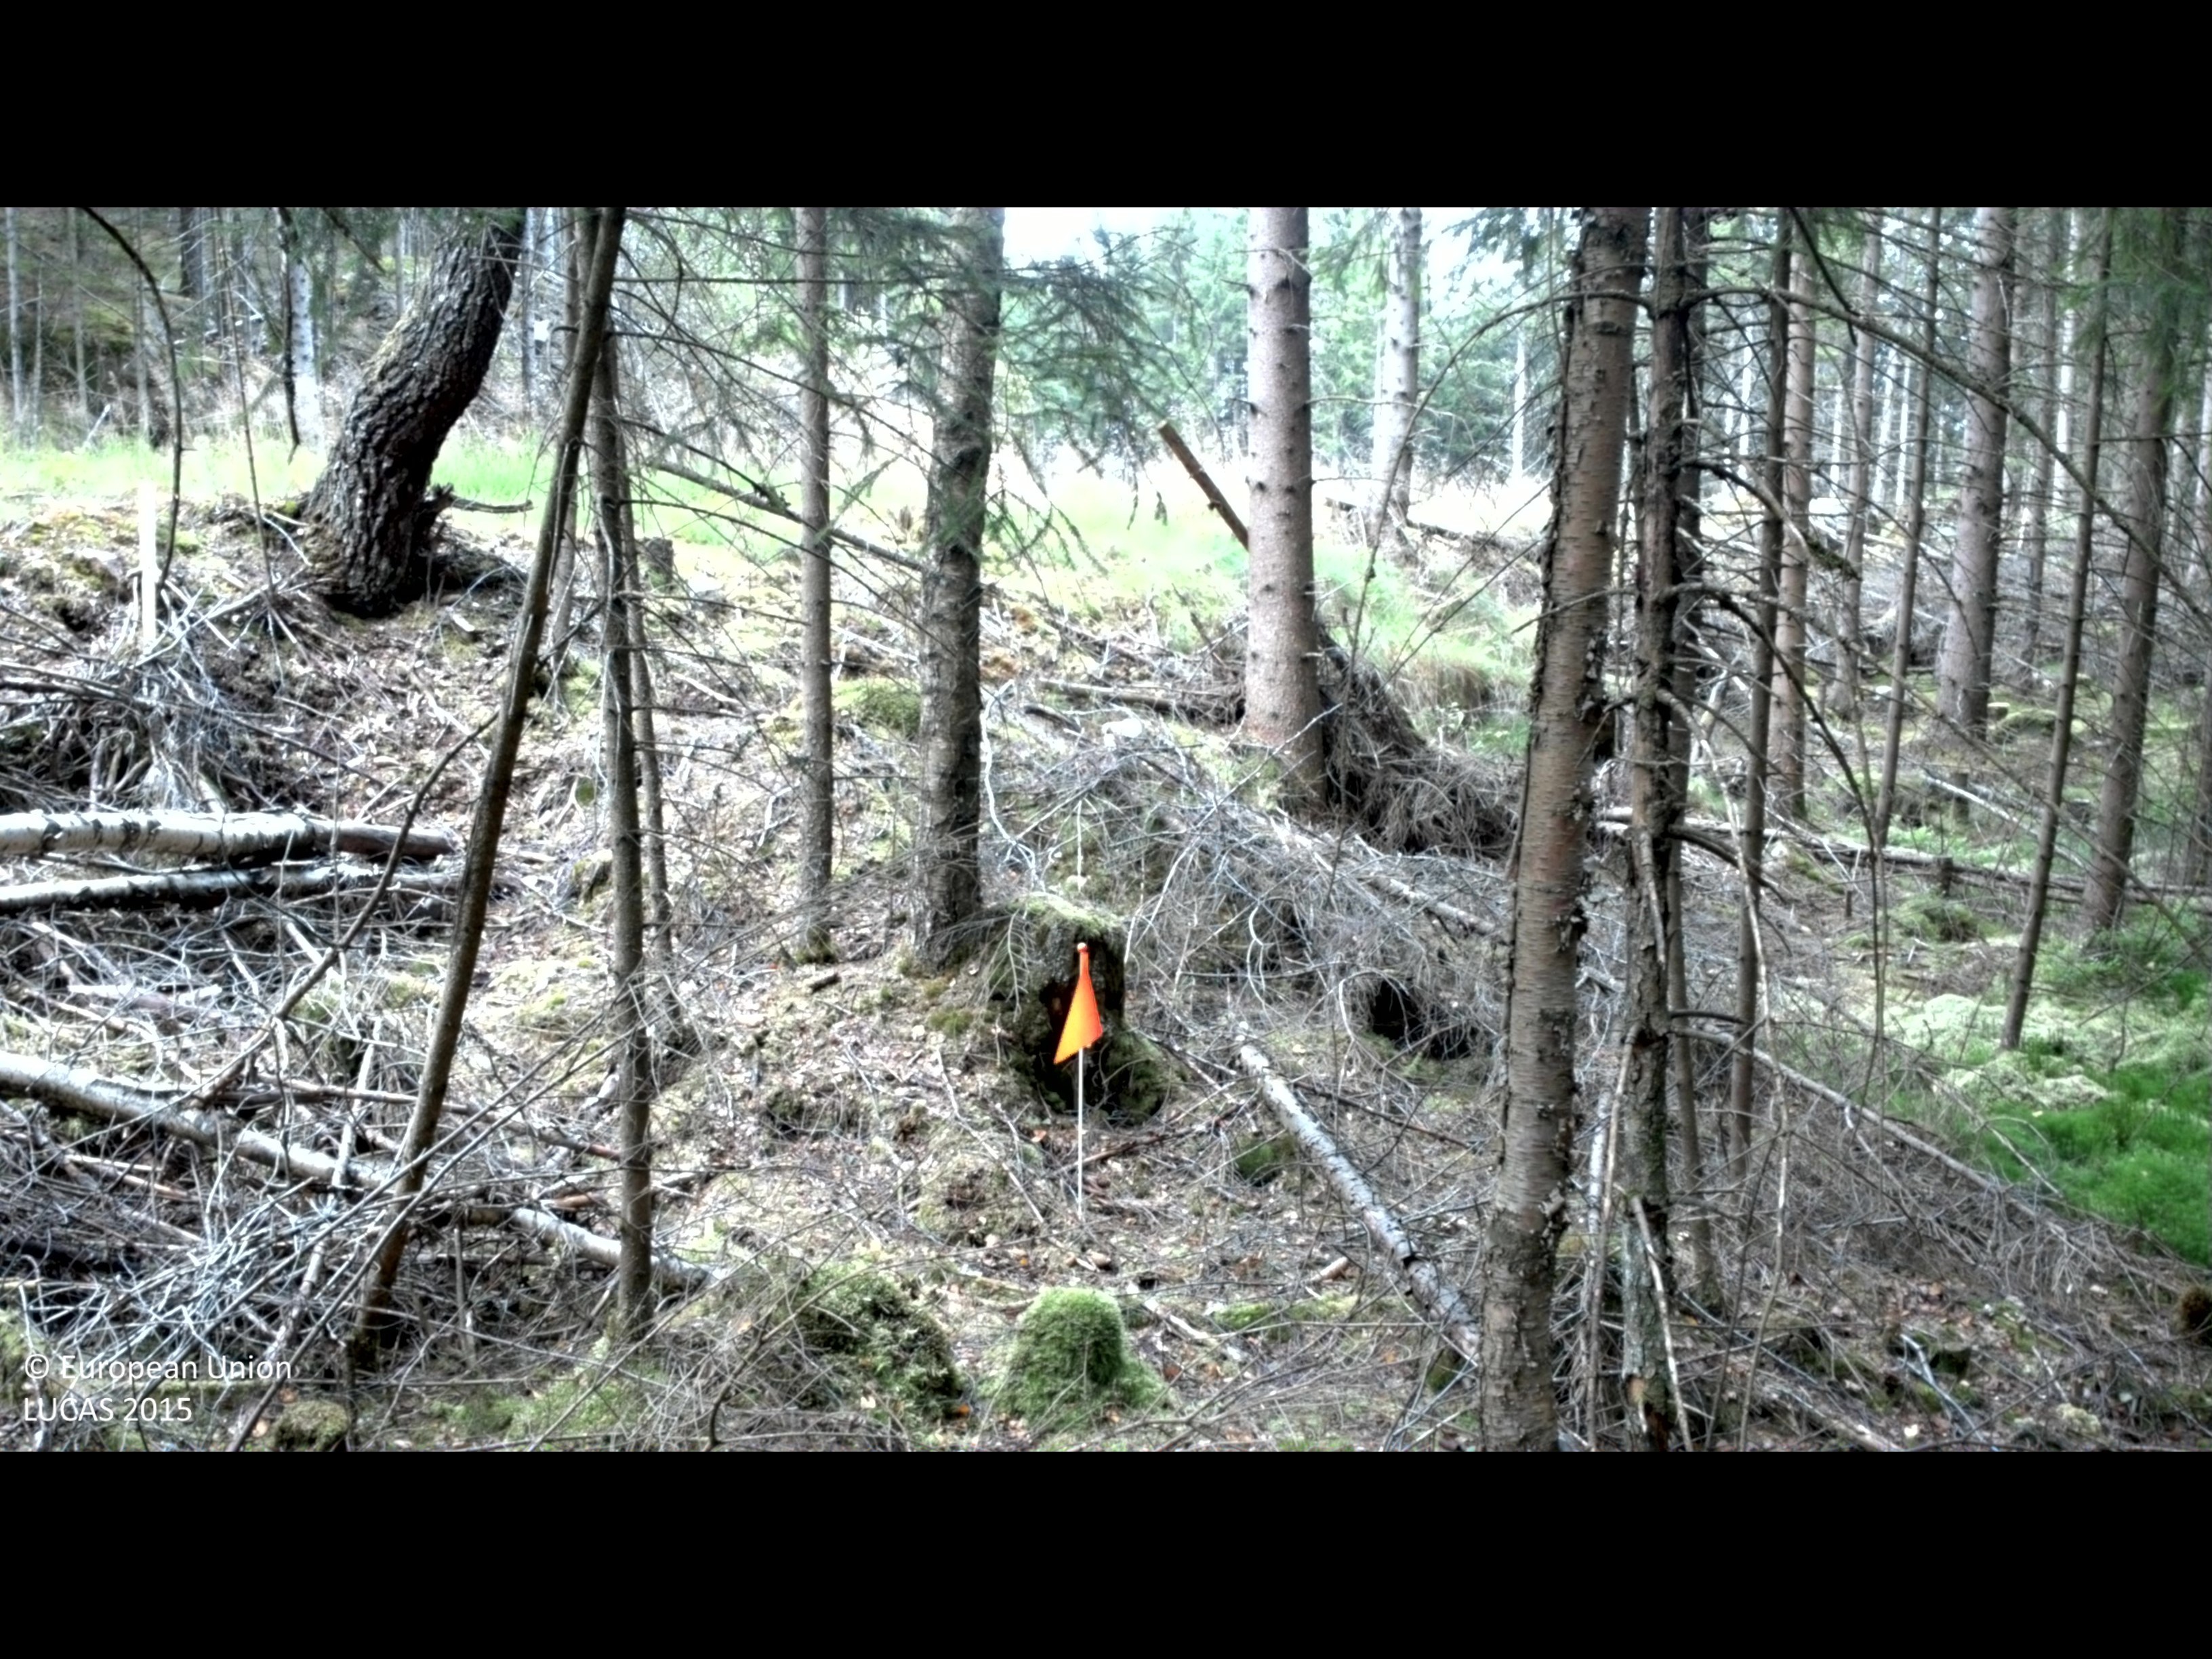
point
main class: Woodland
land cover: Spruce dominated coniferous woodland
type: boreal forest
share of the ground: > 75 %
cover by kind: coniferous forest trees 70 %, lichens and mosses 25 %, broadleaved forest trees 5 %
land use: Forestry
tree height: > 5 m
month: August
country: SE
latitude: 56.8318
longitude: 13.1924
